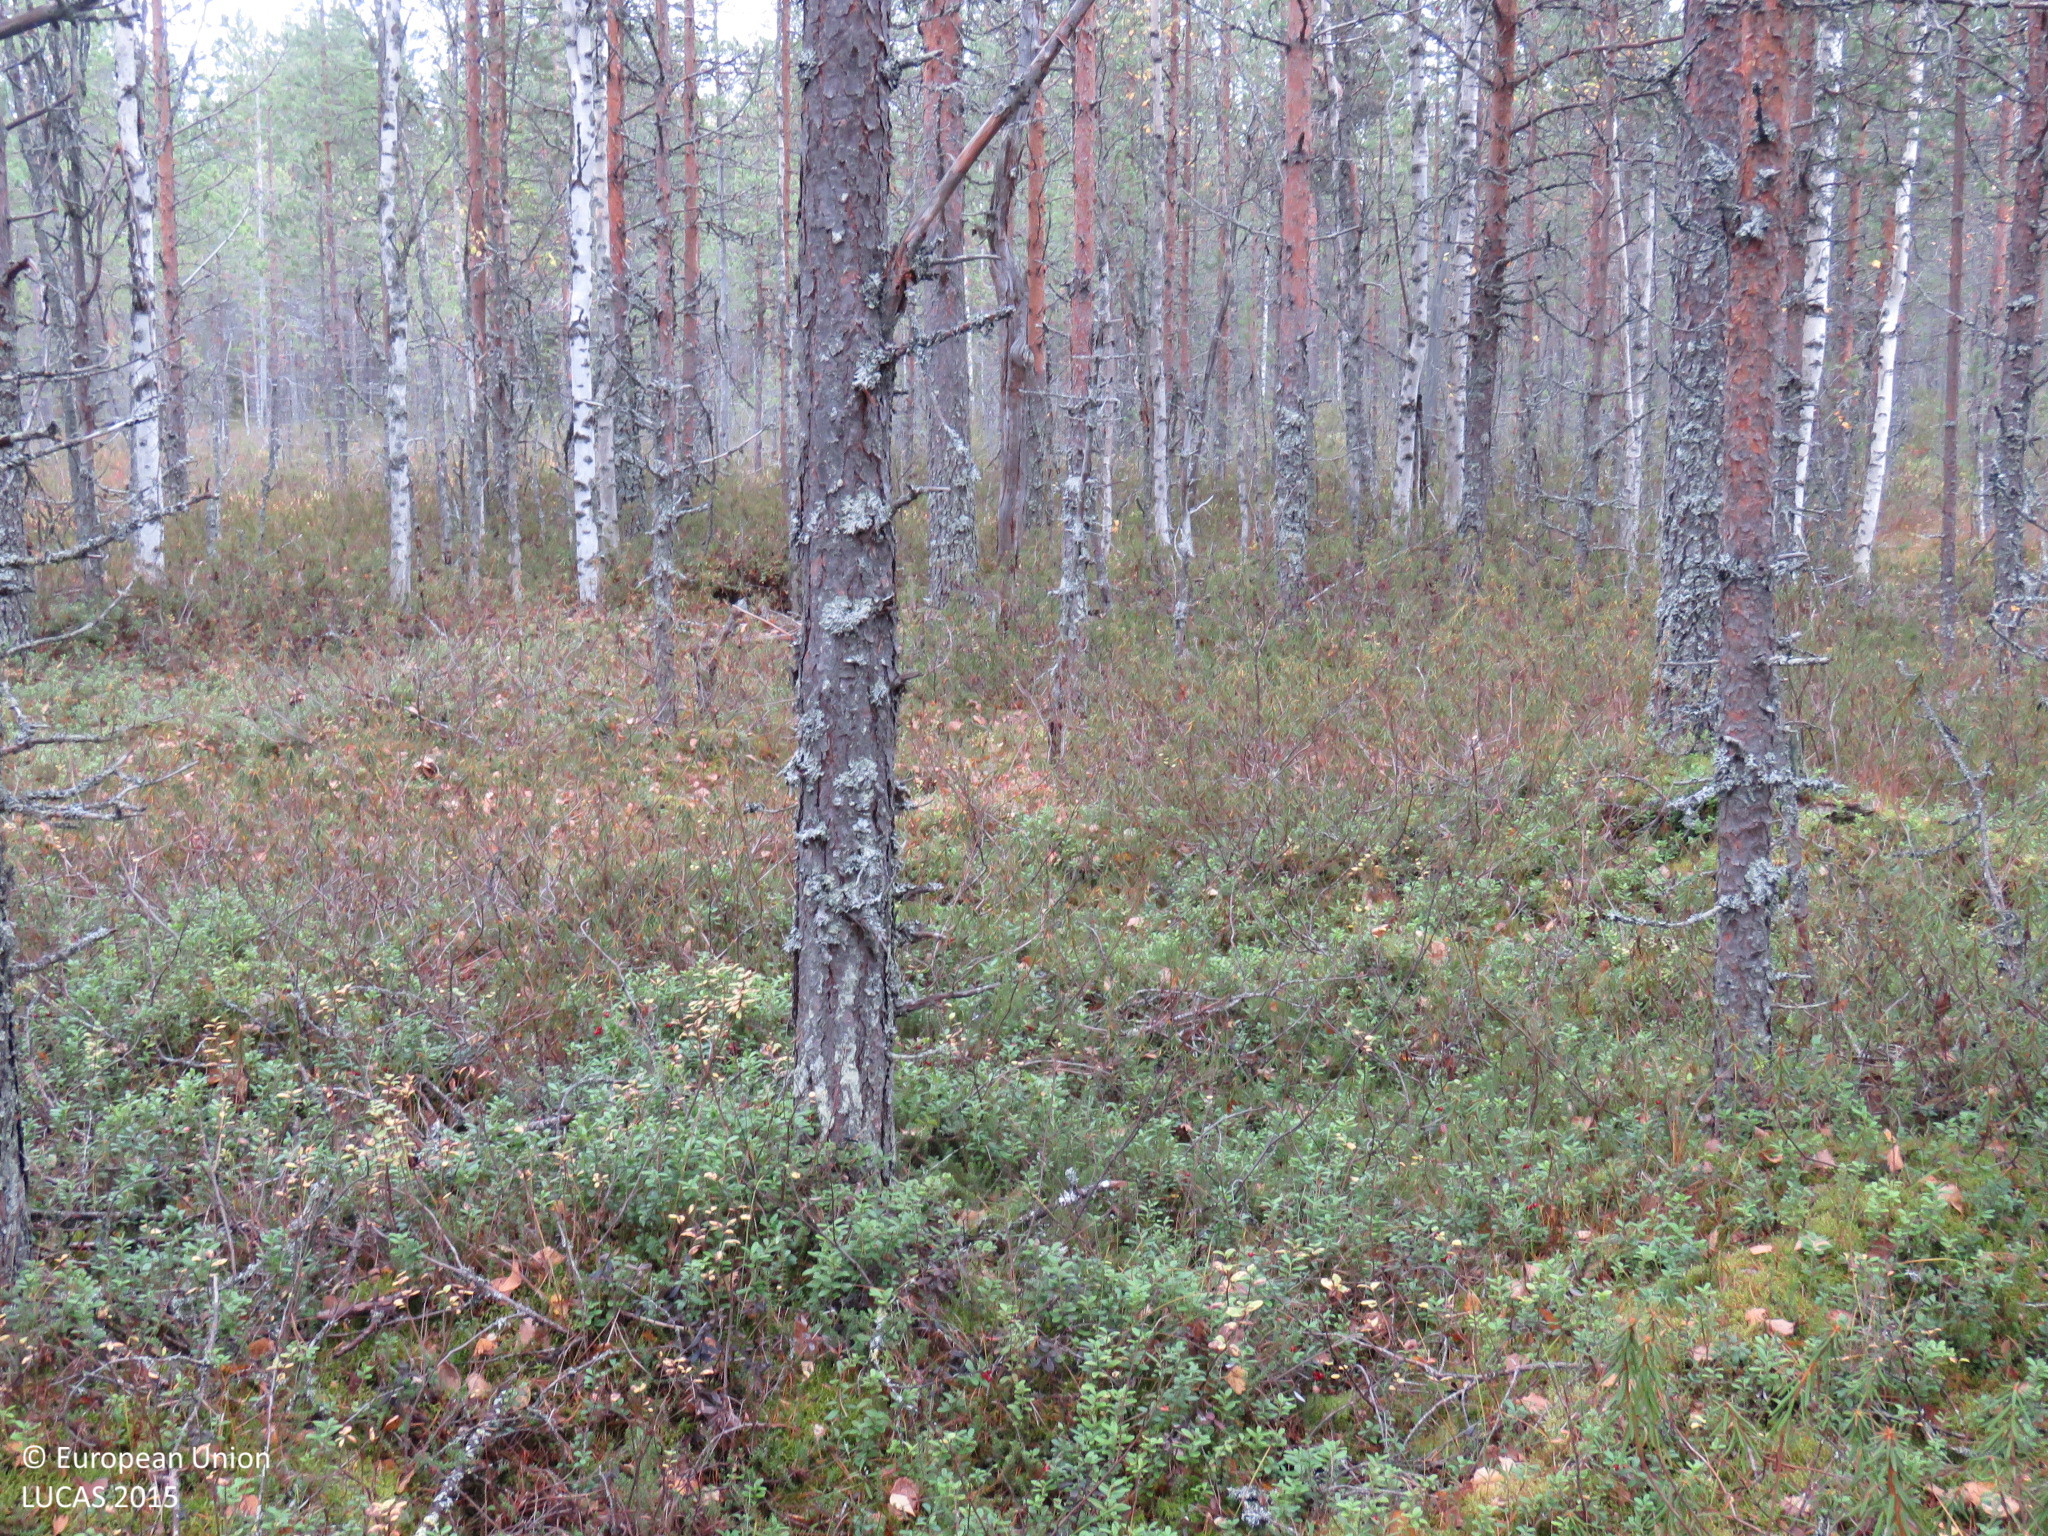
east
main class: Woodland
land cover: Pine dominated coniferous woodland
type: boreal forest
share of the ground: 50 - 75 %
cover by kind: coniferous forest trees 55 %, shrubs 25 %, broadleaved forest trees 15 %, lichens and mosses 5 %
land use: Forestry
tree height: > 5 m
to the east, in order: Pine dominated coniferous woodland; Ditches and canals; Pine dominated coniferous woodland; Ditches and canals; Pine dominated mixed woodland; Ditches and canals; Pine dominated mixed woodland; Ditches and canals; Other mixed woodland
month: September
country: FI
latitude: 64.9045
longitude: 27.3118
